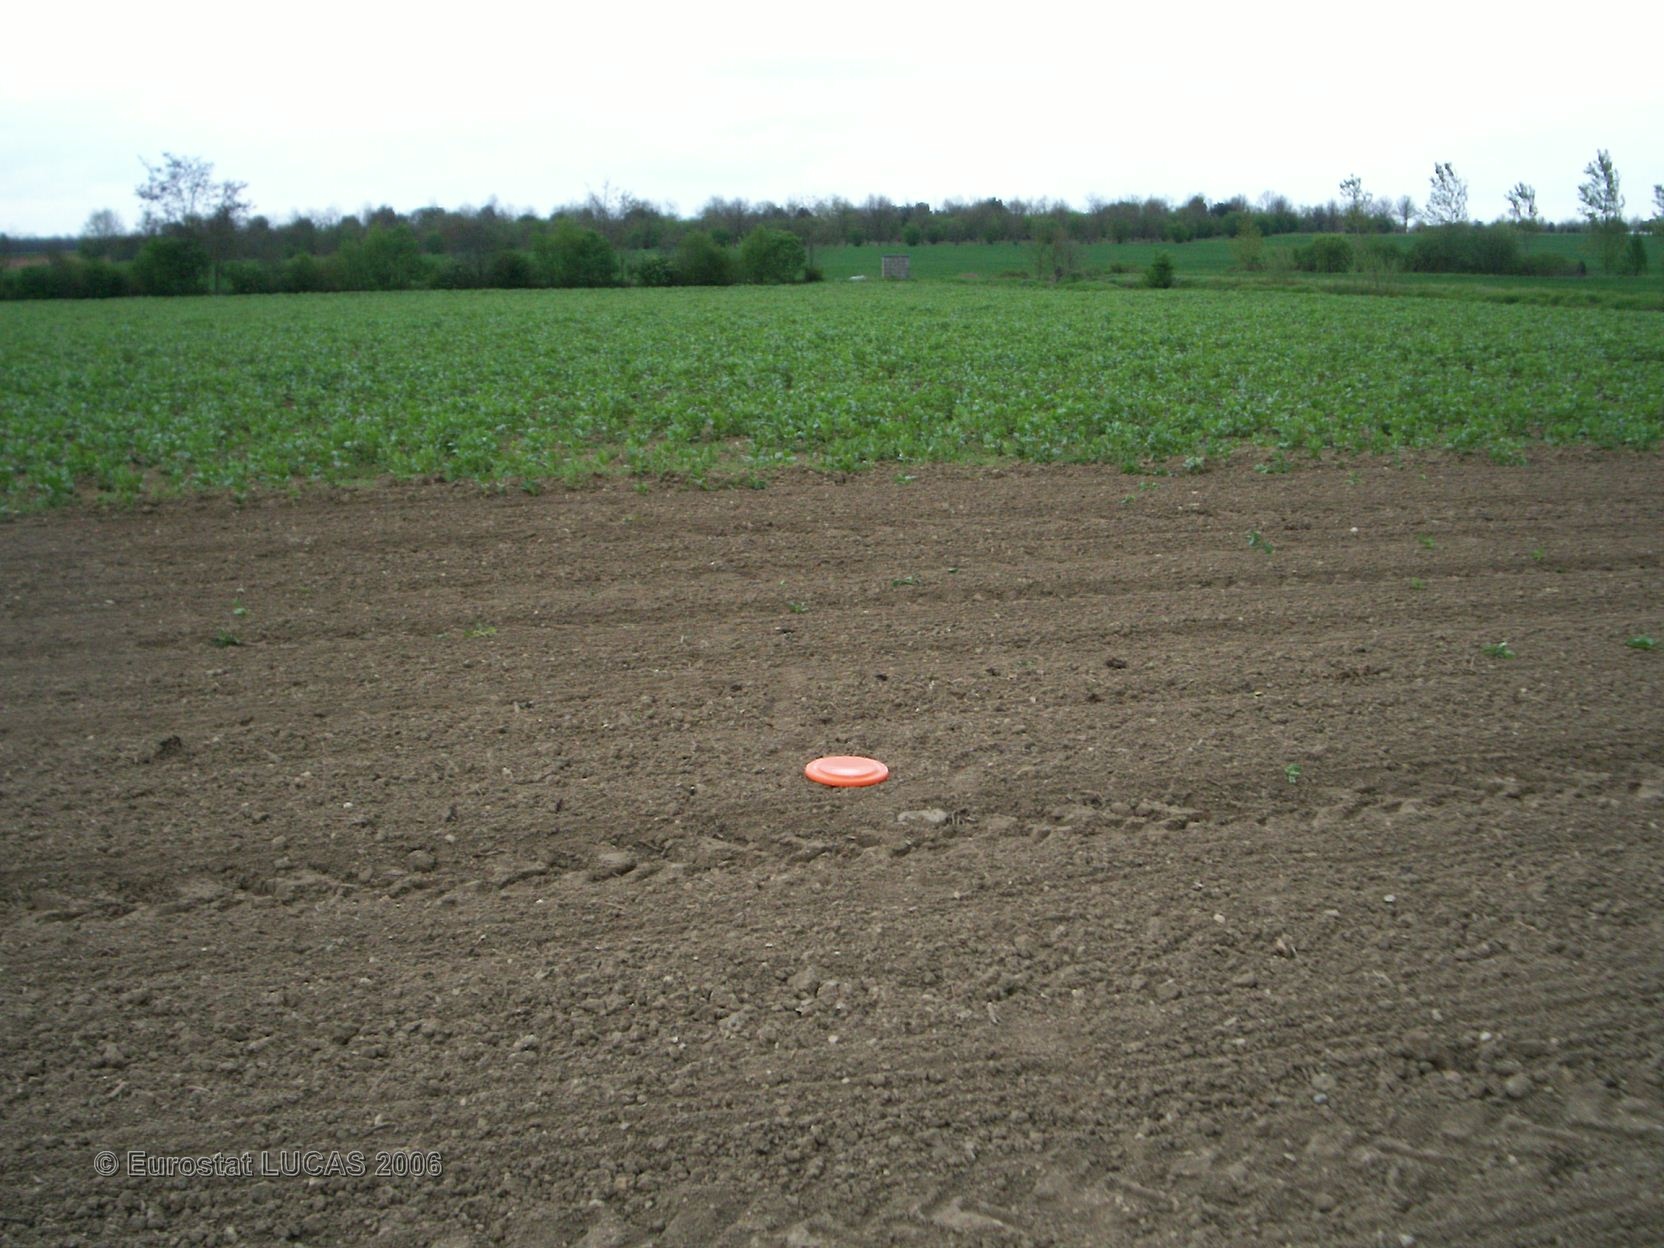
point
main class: Cropland
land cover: Maize
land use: Agriculture (excluding fallow land and kitchen gardens)
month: June
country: FR
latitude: 47.0342
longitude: 0.3065
